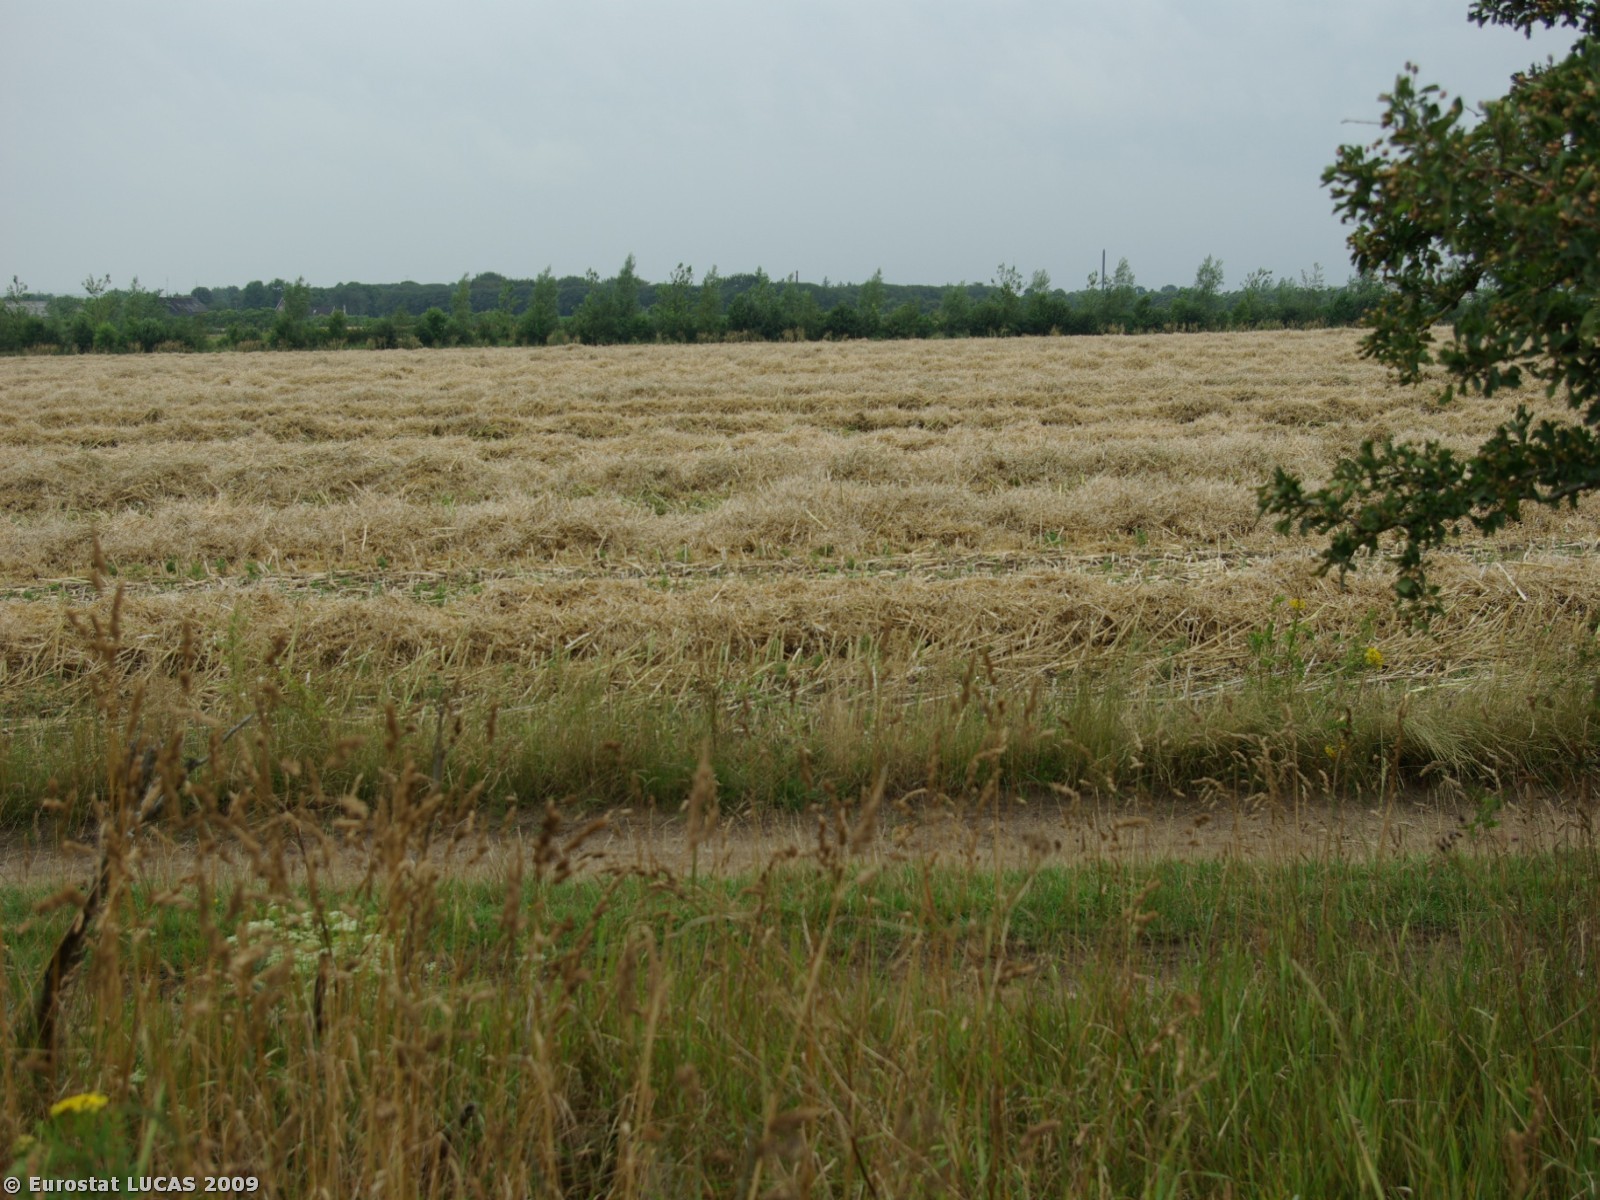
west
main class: Cropland
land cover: Maize
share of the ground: > 75 %
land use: Agriculture (excluding fallow land and kitchen gardens)
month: July
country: DK
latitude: 55.1574
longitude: 8.7925
